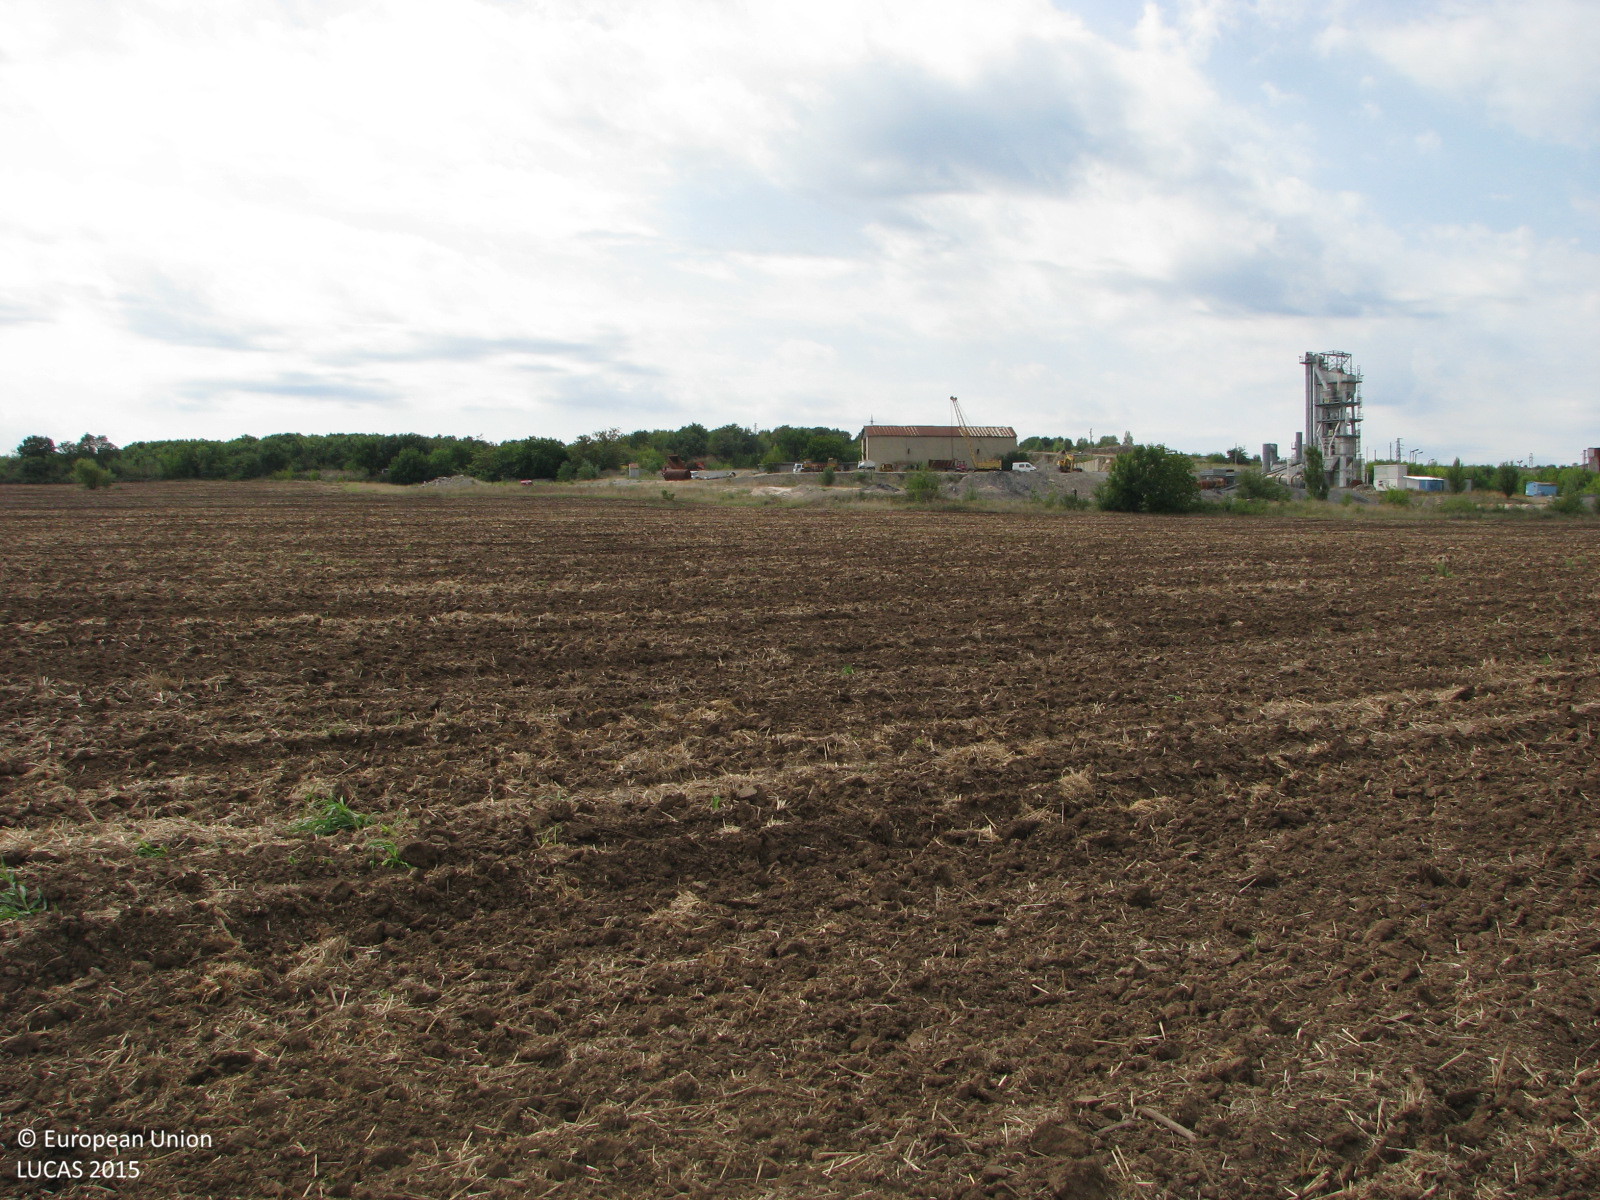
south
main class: Cropland
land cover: Common wheat
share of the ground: < 10 %
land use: Agriculture (excluding fallow land and kitchen gardens)
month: September
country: BG
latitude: 42.4492
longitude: 26.0455
